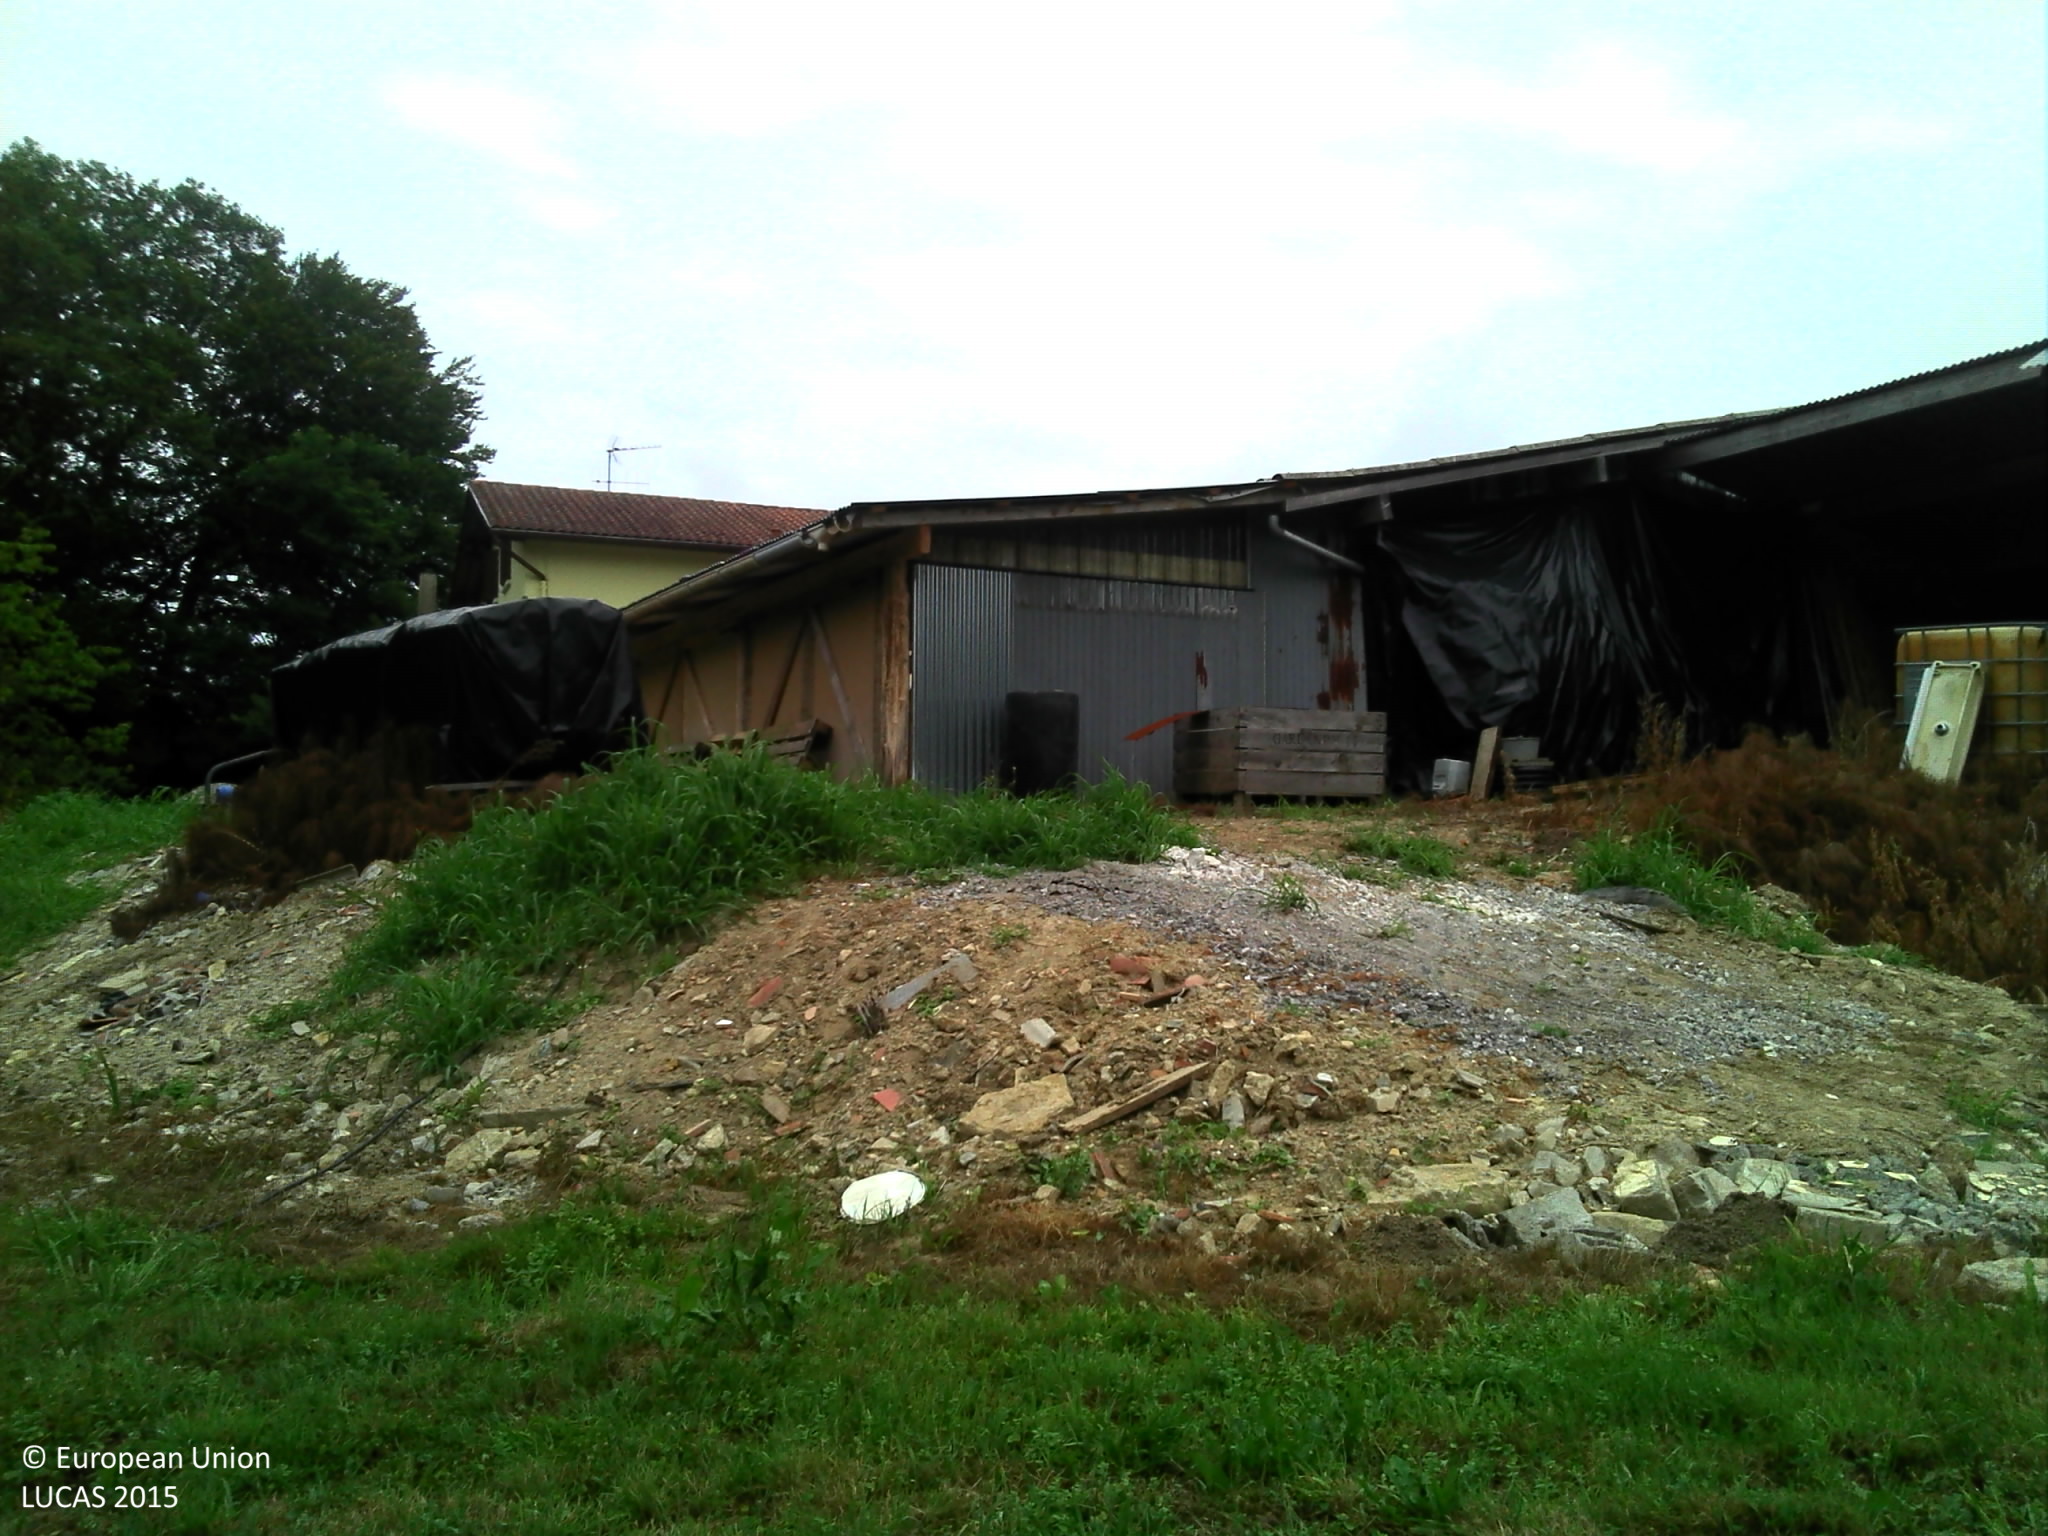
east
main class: Grassland
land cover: Grassland without tree/shrub cover
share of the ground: > 75 %
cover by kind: herbaceous plants 95 %, lichens and mosses 5 %
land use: Residential
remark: Clear cut
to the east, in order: Grassland without tree/shrub cover; Artificial constructions in urban areas; Spontaneously vegetated surfaces; Broadleaved woodland; Ditches and canals; Broadleaved woodland; Grassland without tree/shrub cover; Artificial constructions in urban areas; Broadleaved woodland; Grassland without tree/shrub cover
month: July
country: FR
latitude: 43.5554
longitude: -1.2440
